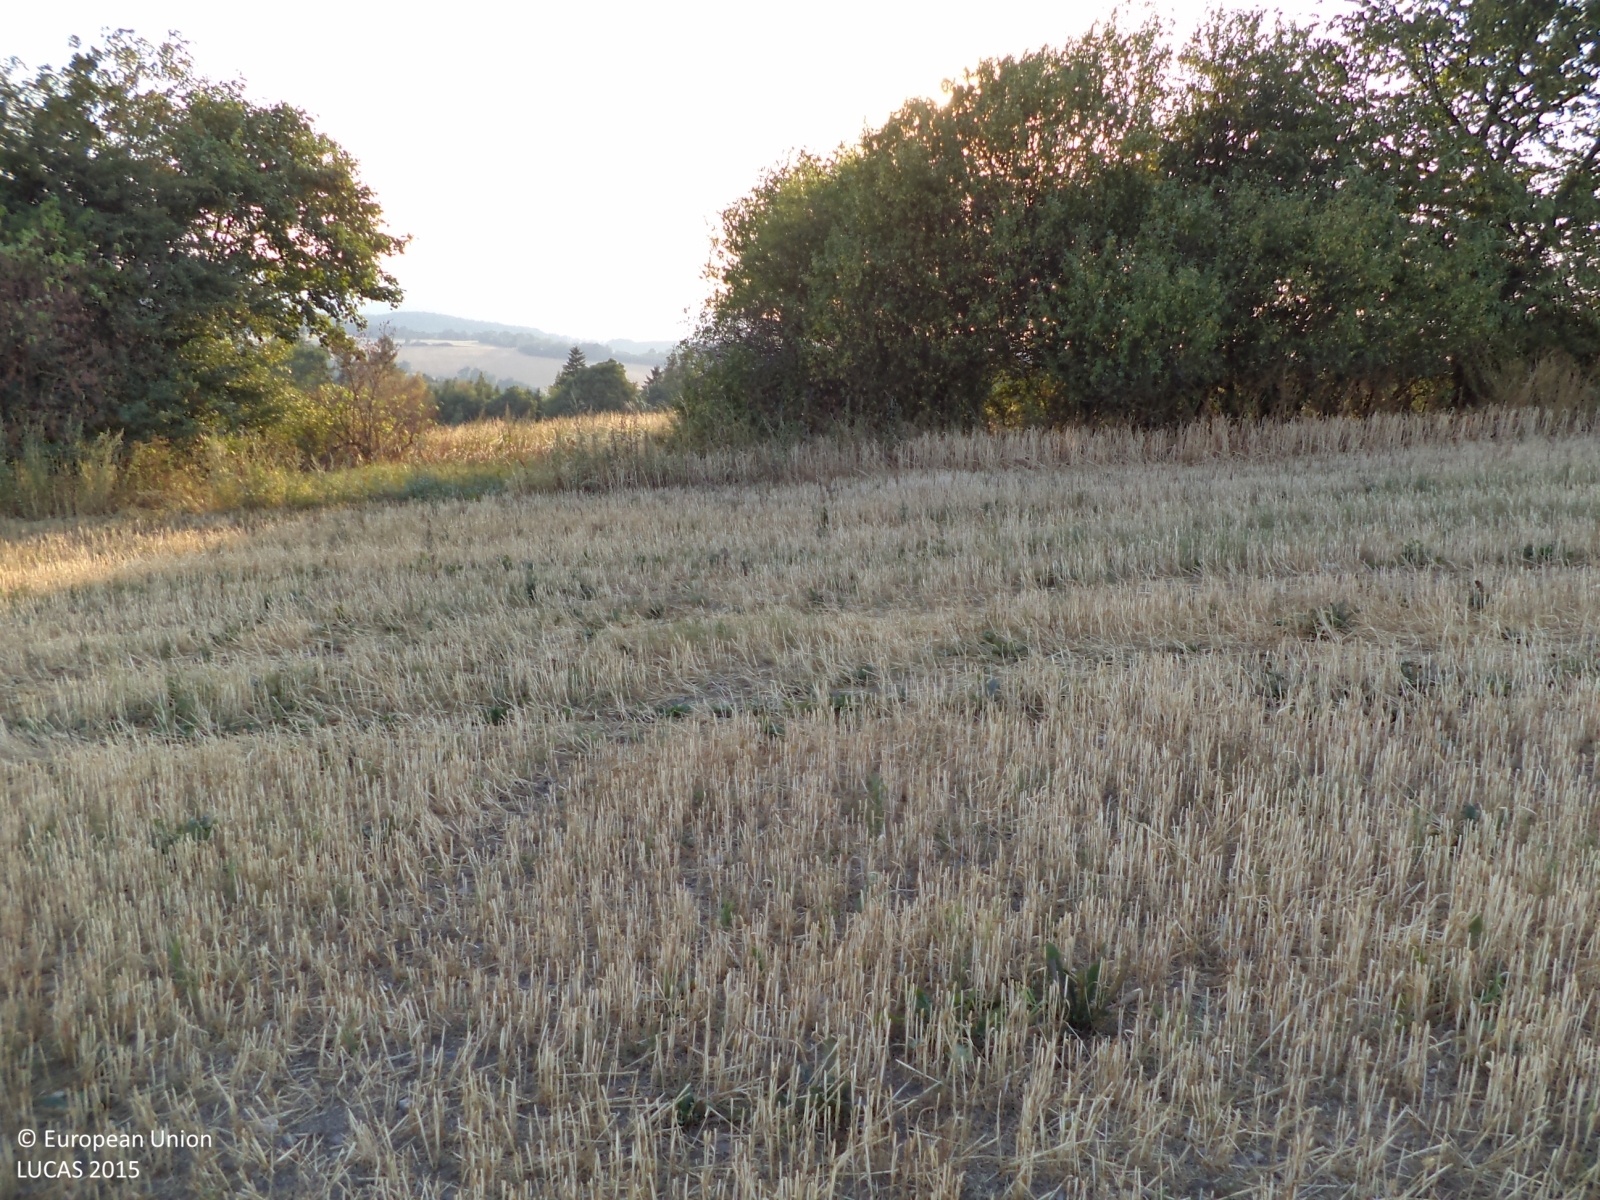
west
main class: Cropland
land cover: Barley
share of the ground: 10 - 25 %
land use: Agriculture (excluding fallow land and kitchen gardens)
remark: Harvested field
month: August
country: CZ
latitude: 49.5509
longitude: 14.6045
